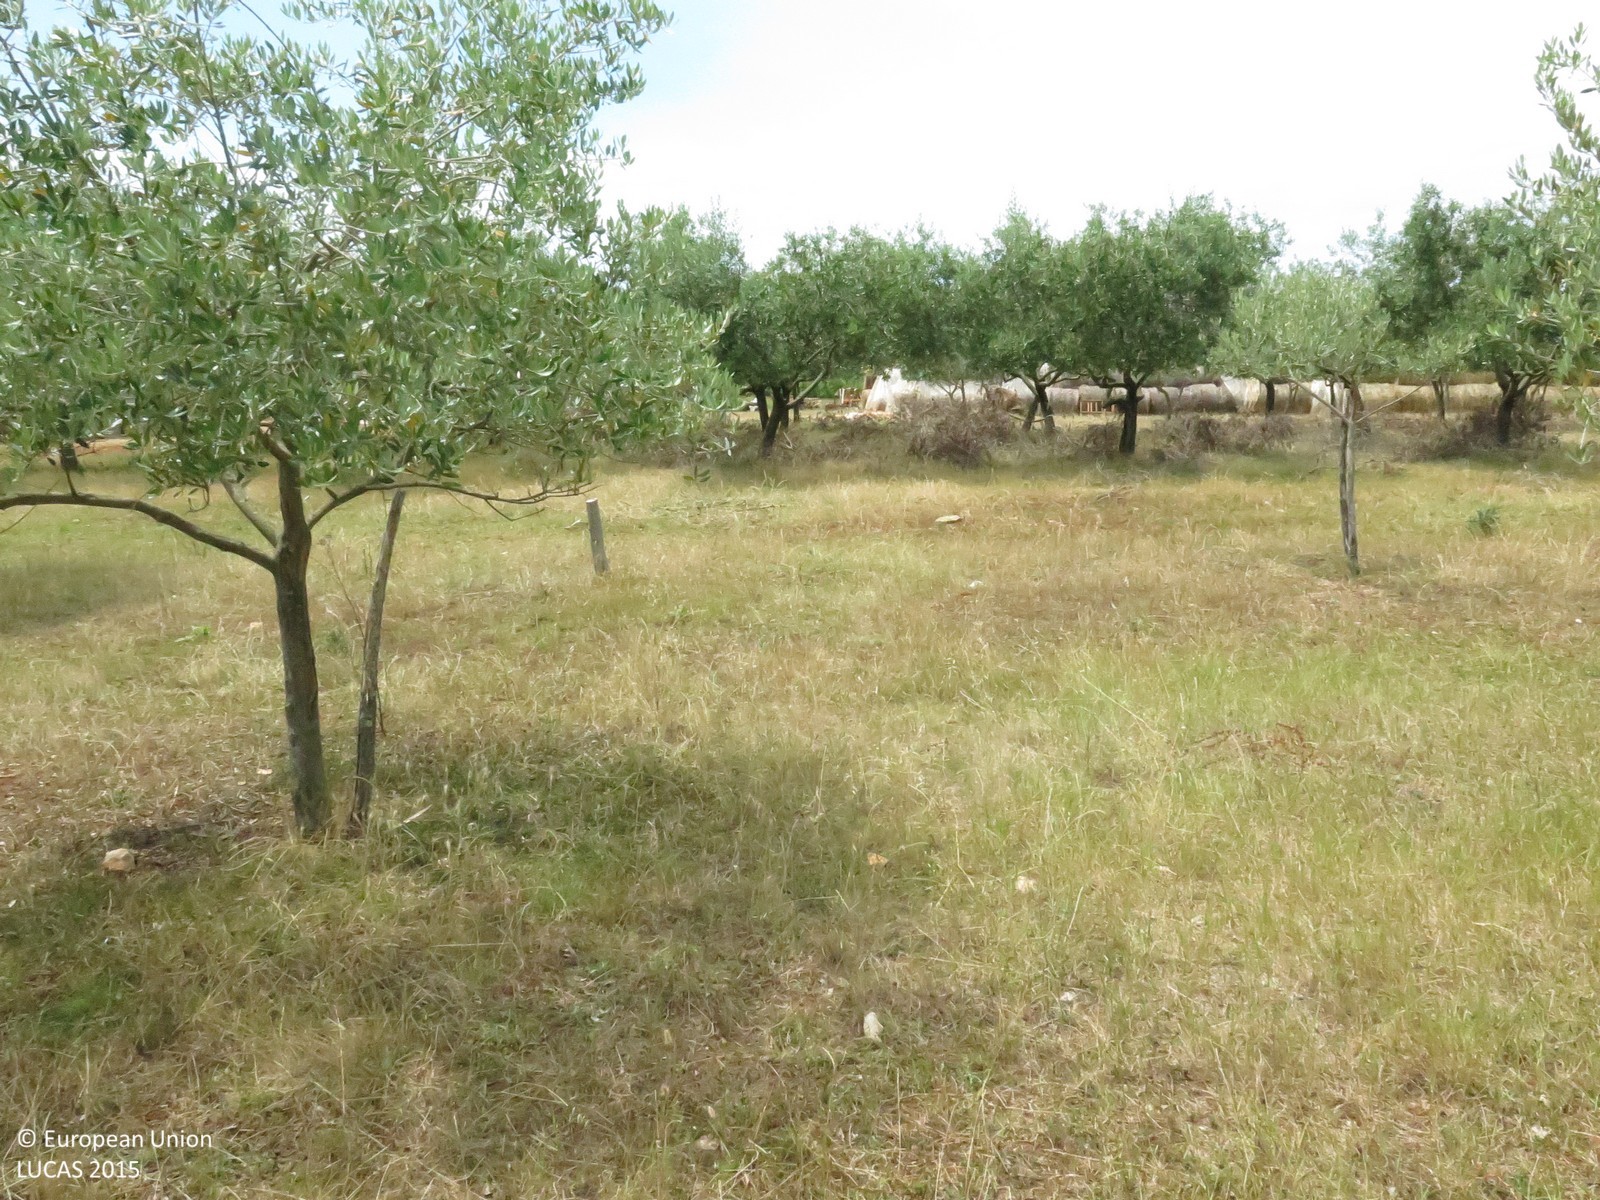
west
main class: Cropland
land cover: Olive groves
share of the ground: 50 - 75 %
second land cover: Grassland without tree/shrub cover
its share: > 75 %
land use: Agriculture (excluding fallow land and kitchen gardens)
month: June
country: HR
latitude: 45.2771
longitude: 13.7044
